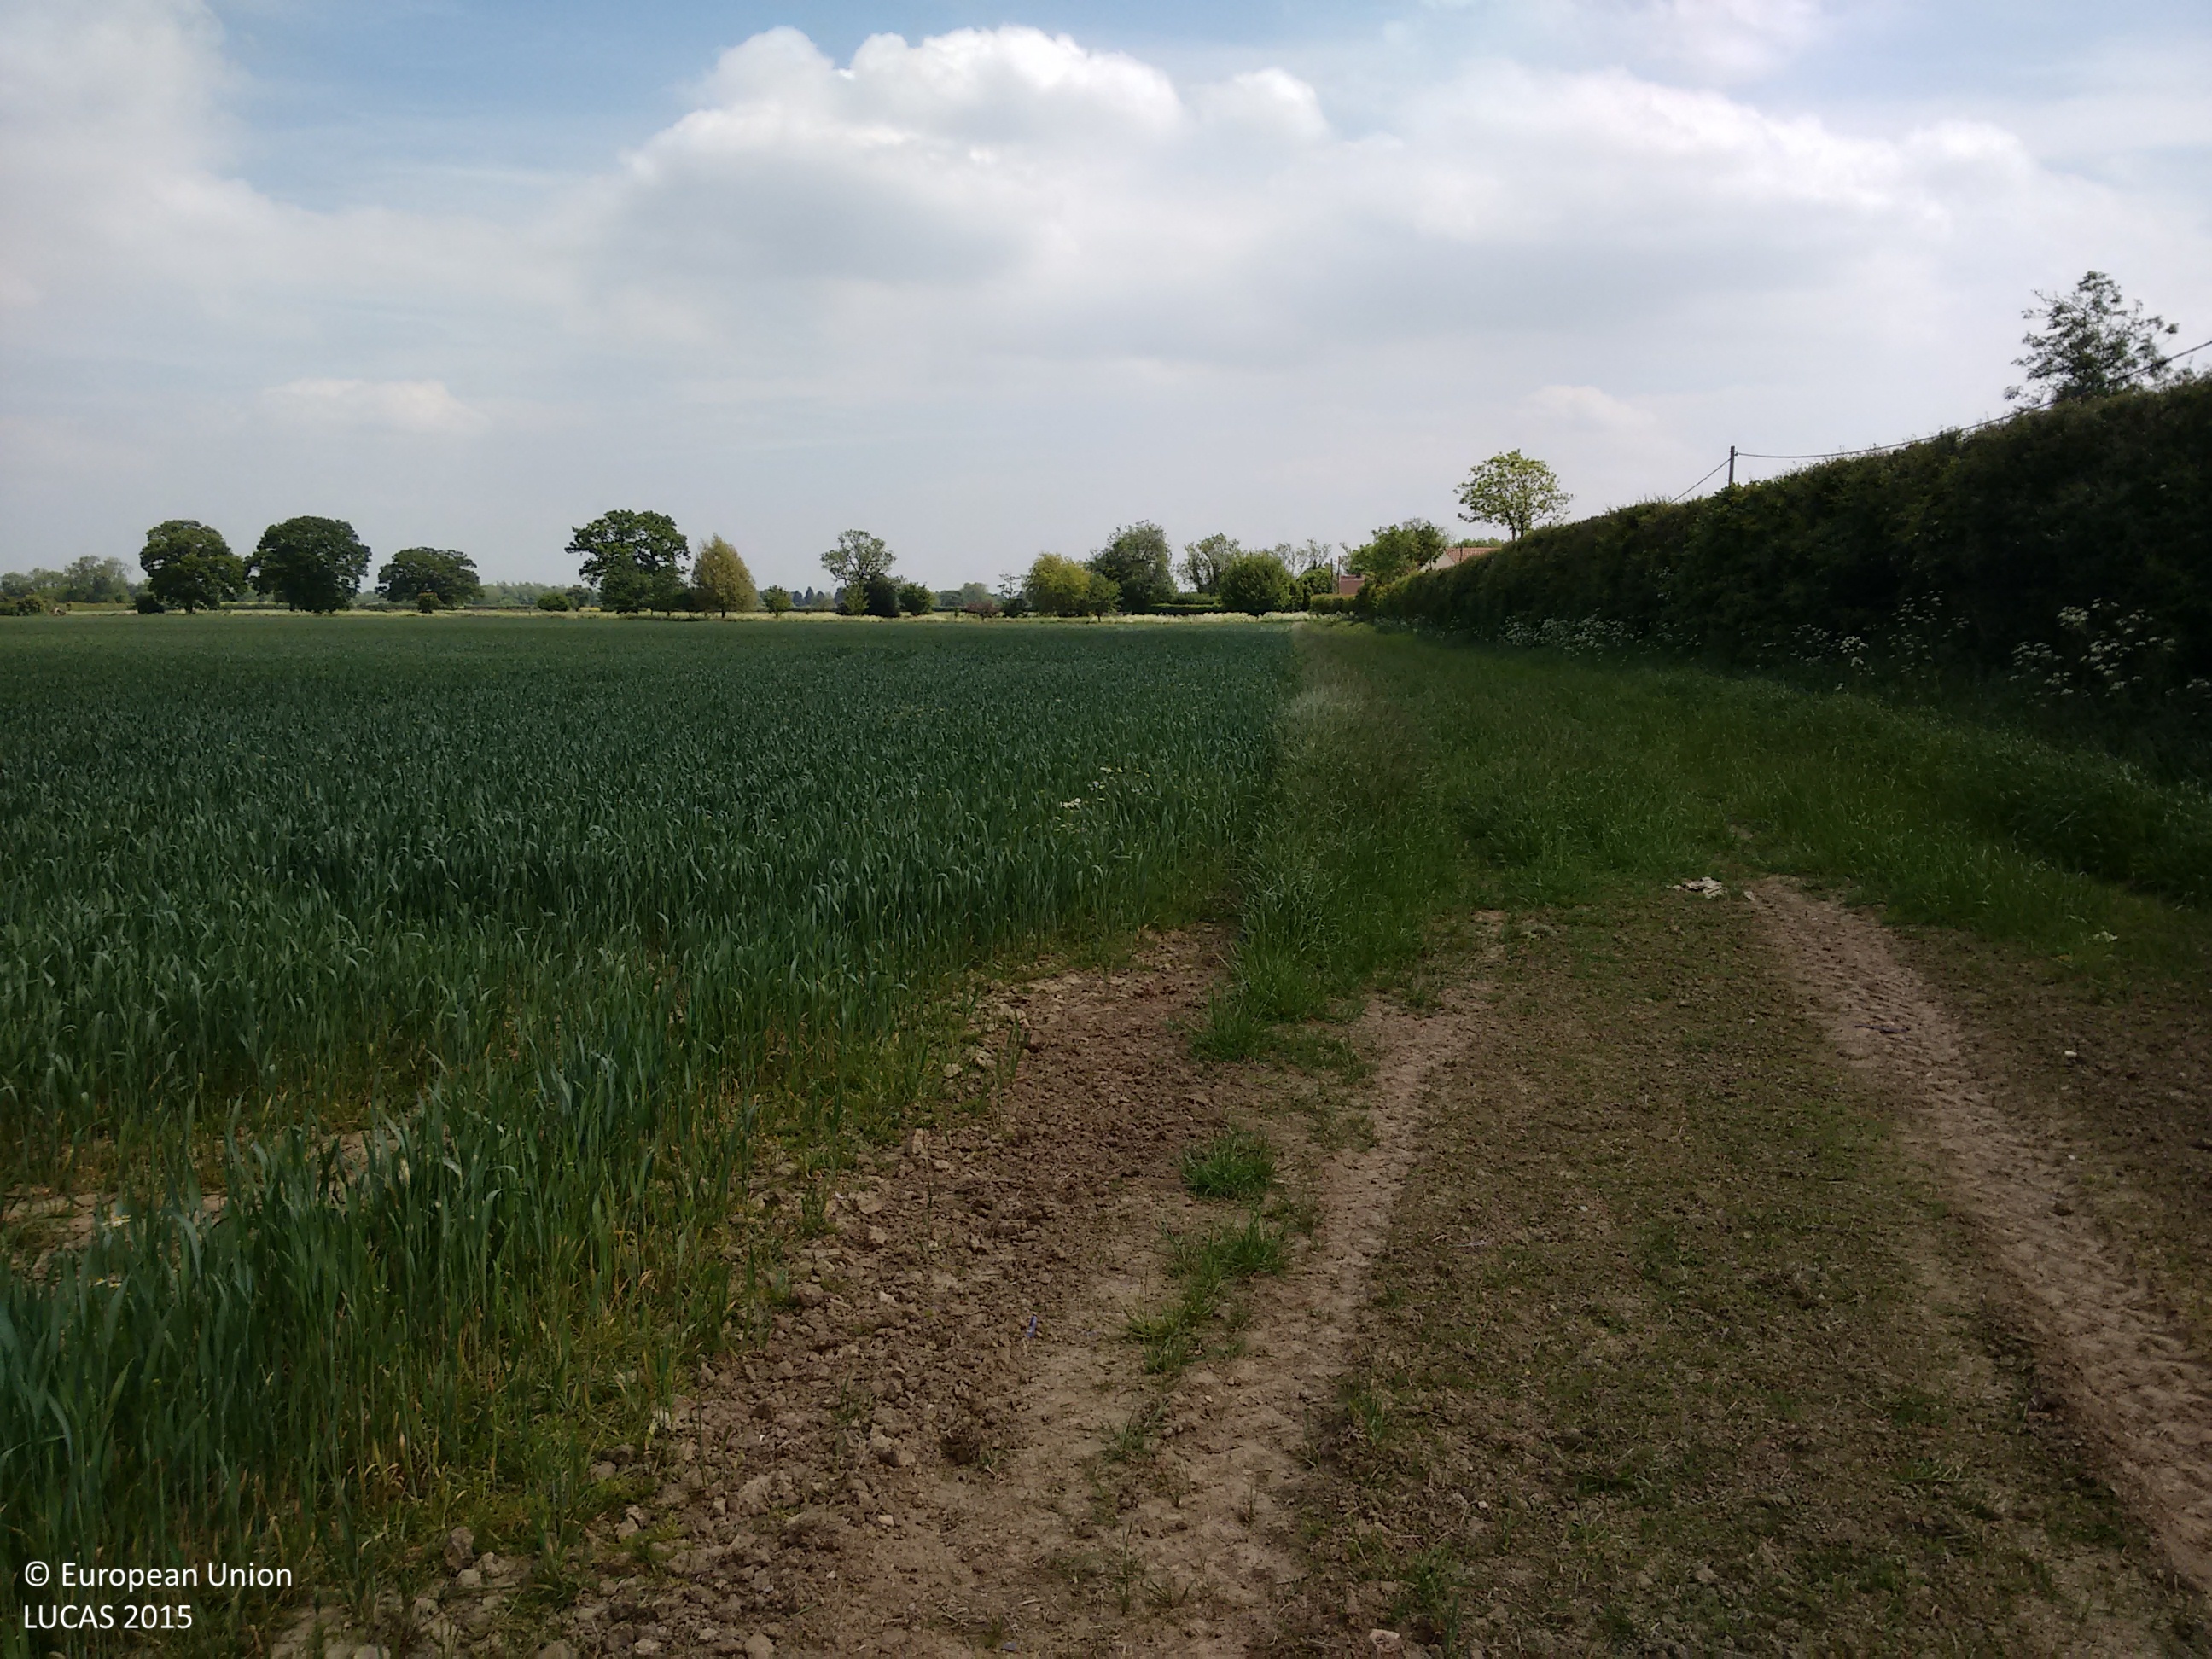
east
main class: Cropland
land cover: Common wheat
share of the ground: > 75 %
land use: Agriculture (excluding fallow land and kitchen gardens)
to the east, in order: Tracks; Grass margins; Common wheat; Grass margins; Tracks; Grass margins; Fences; Grassland with sparse tree/shrub cover; Single bushes/trees; Grassland without tree/shrub cover
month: June
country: GB
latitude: 53.9057
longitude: -1.1101
